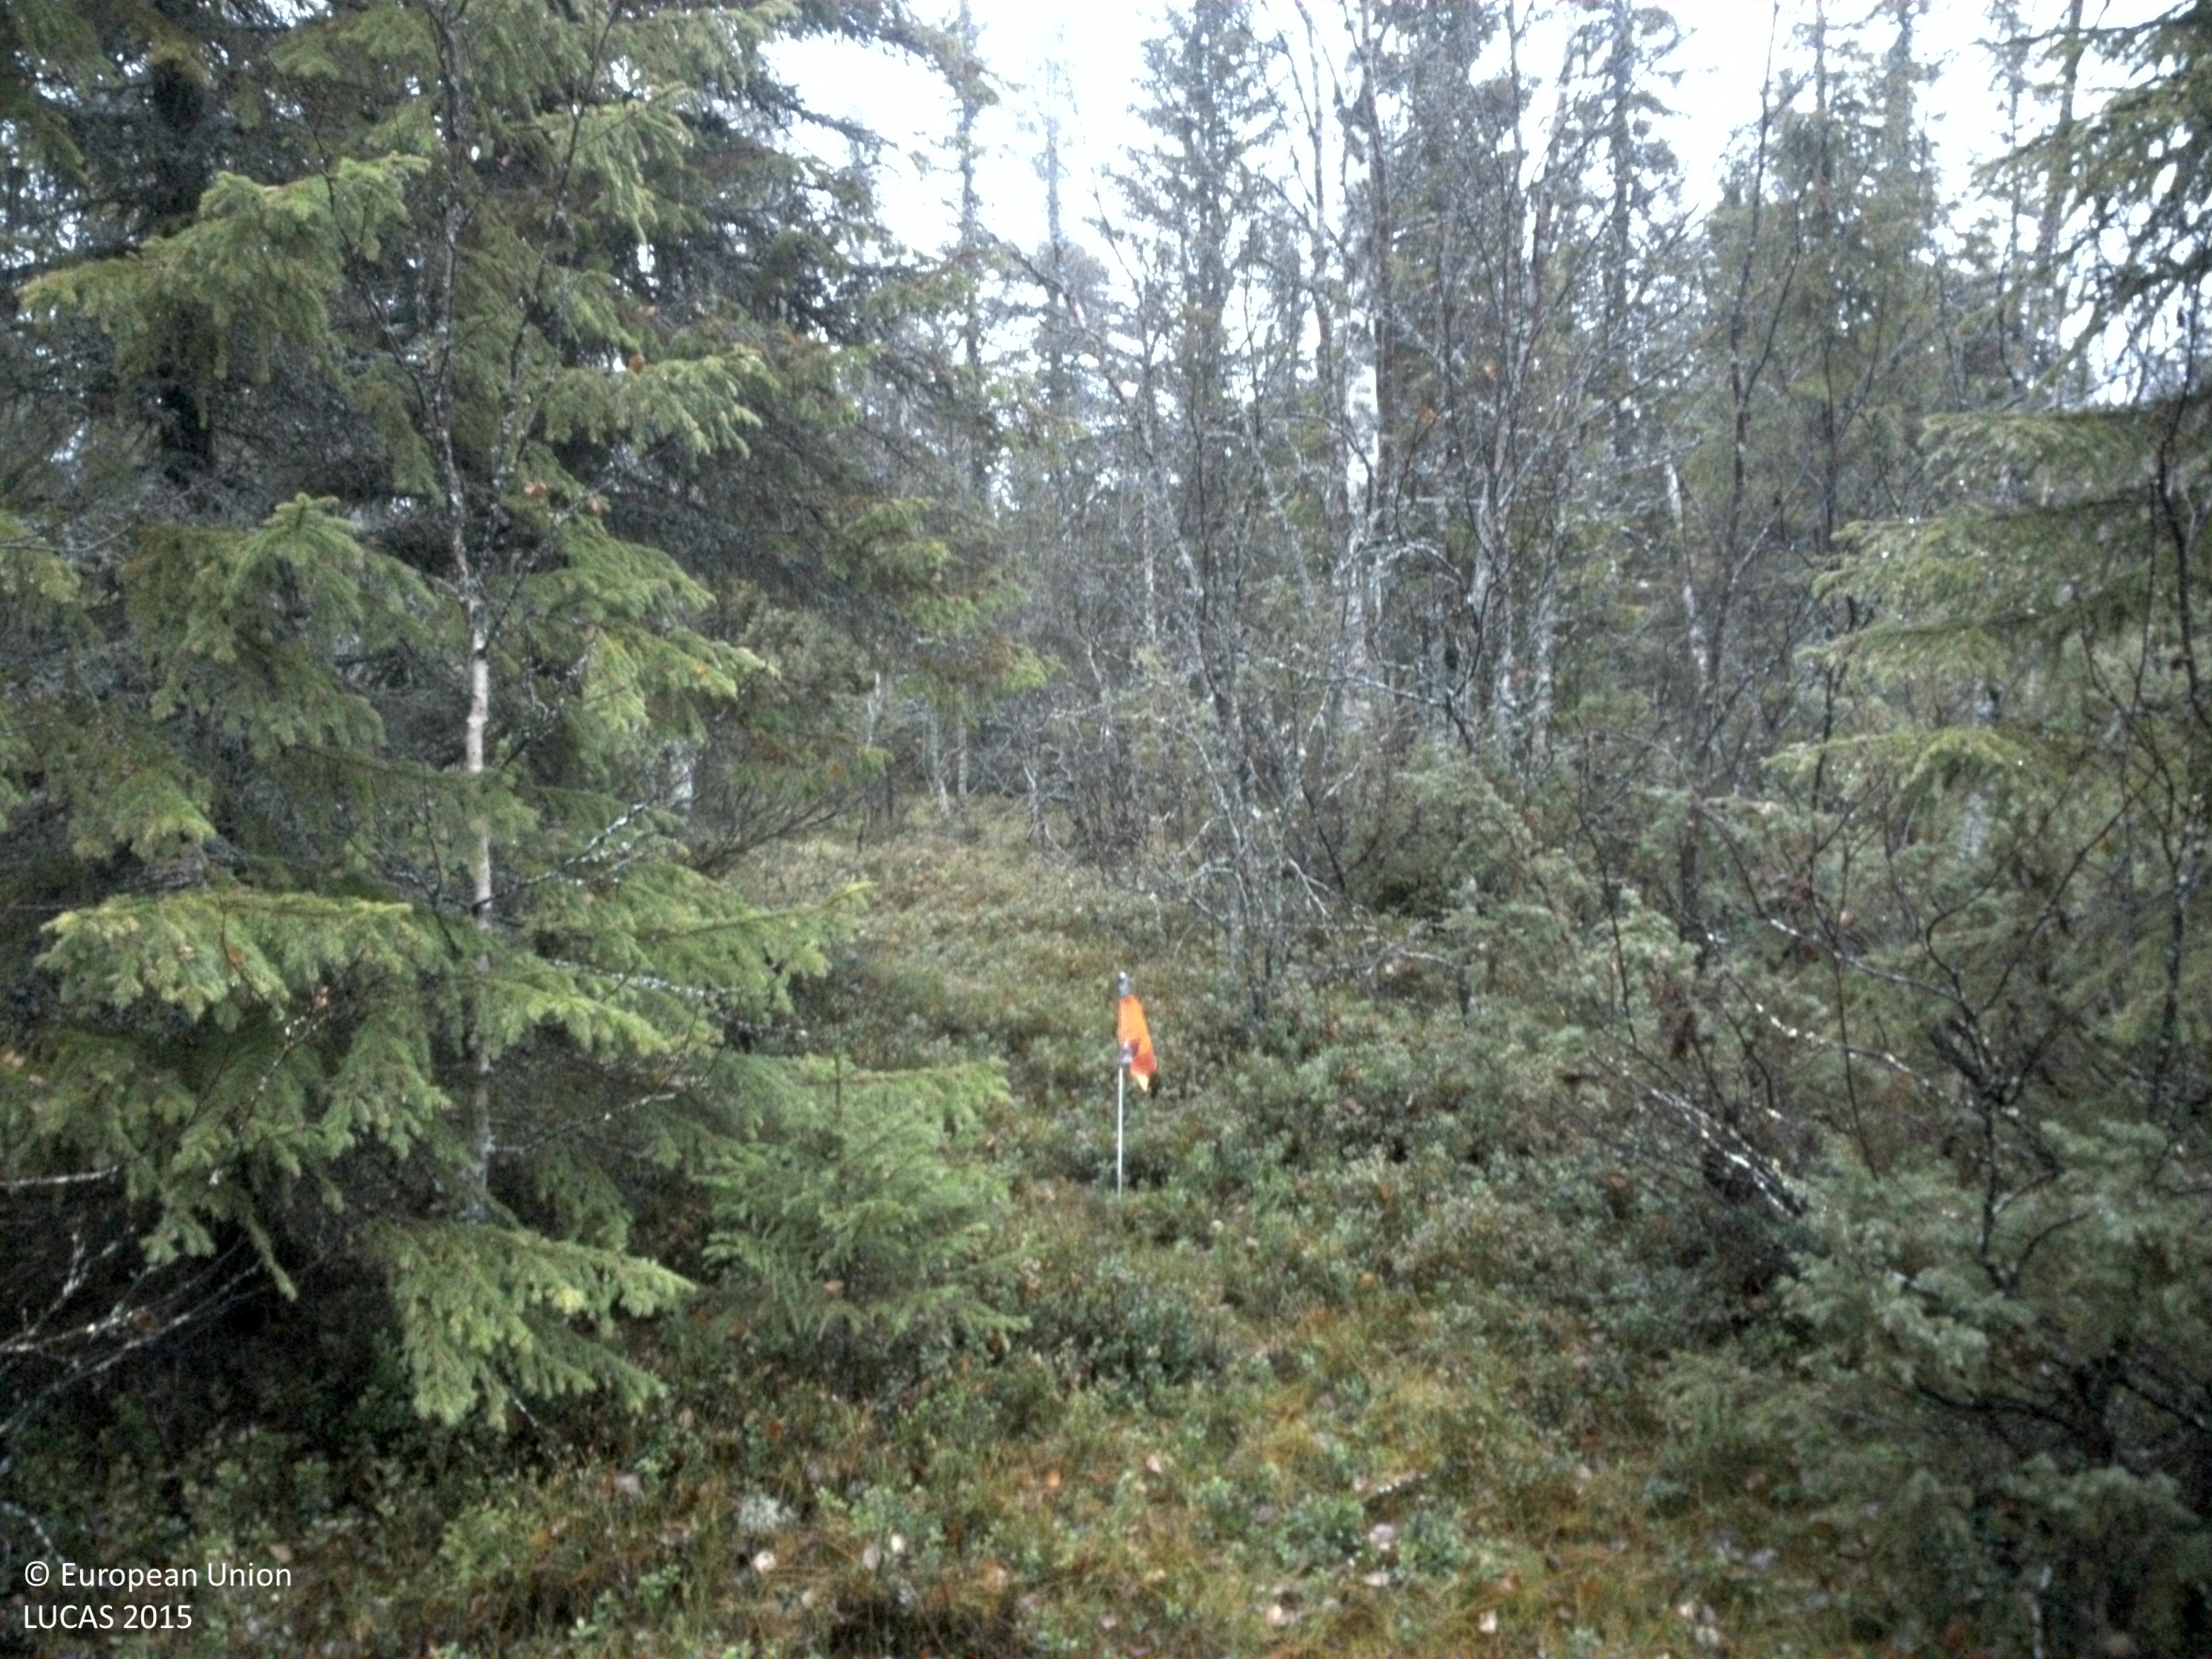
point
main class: Woodland
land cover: Spruce dominated mixed woodland
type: boreal forest
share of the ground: 25 - 50 %
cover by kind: shrubs 40 %, coniferous forest trees 30 %, broadleaved forest trees 15 %, herbaceous plants 10 %, lichens and mosses 5 %
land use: Forestry
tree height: > 5 m
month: October
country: SE
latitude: 64.5118
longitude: 17.4858
